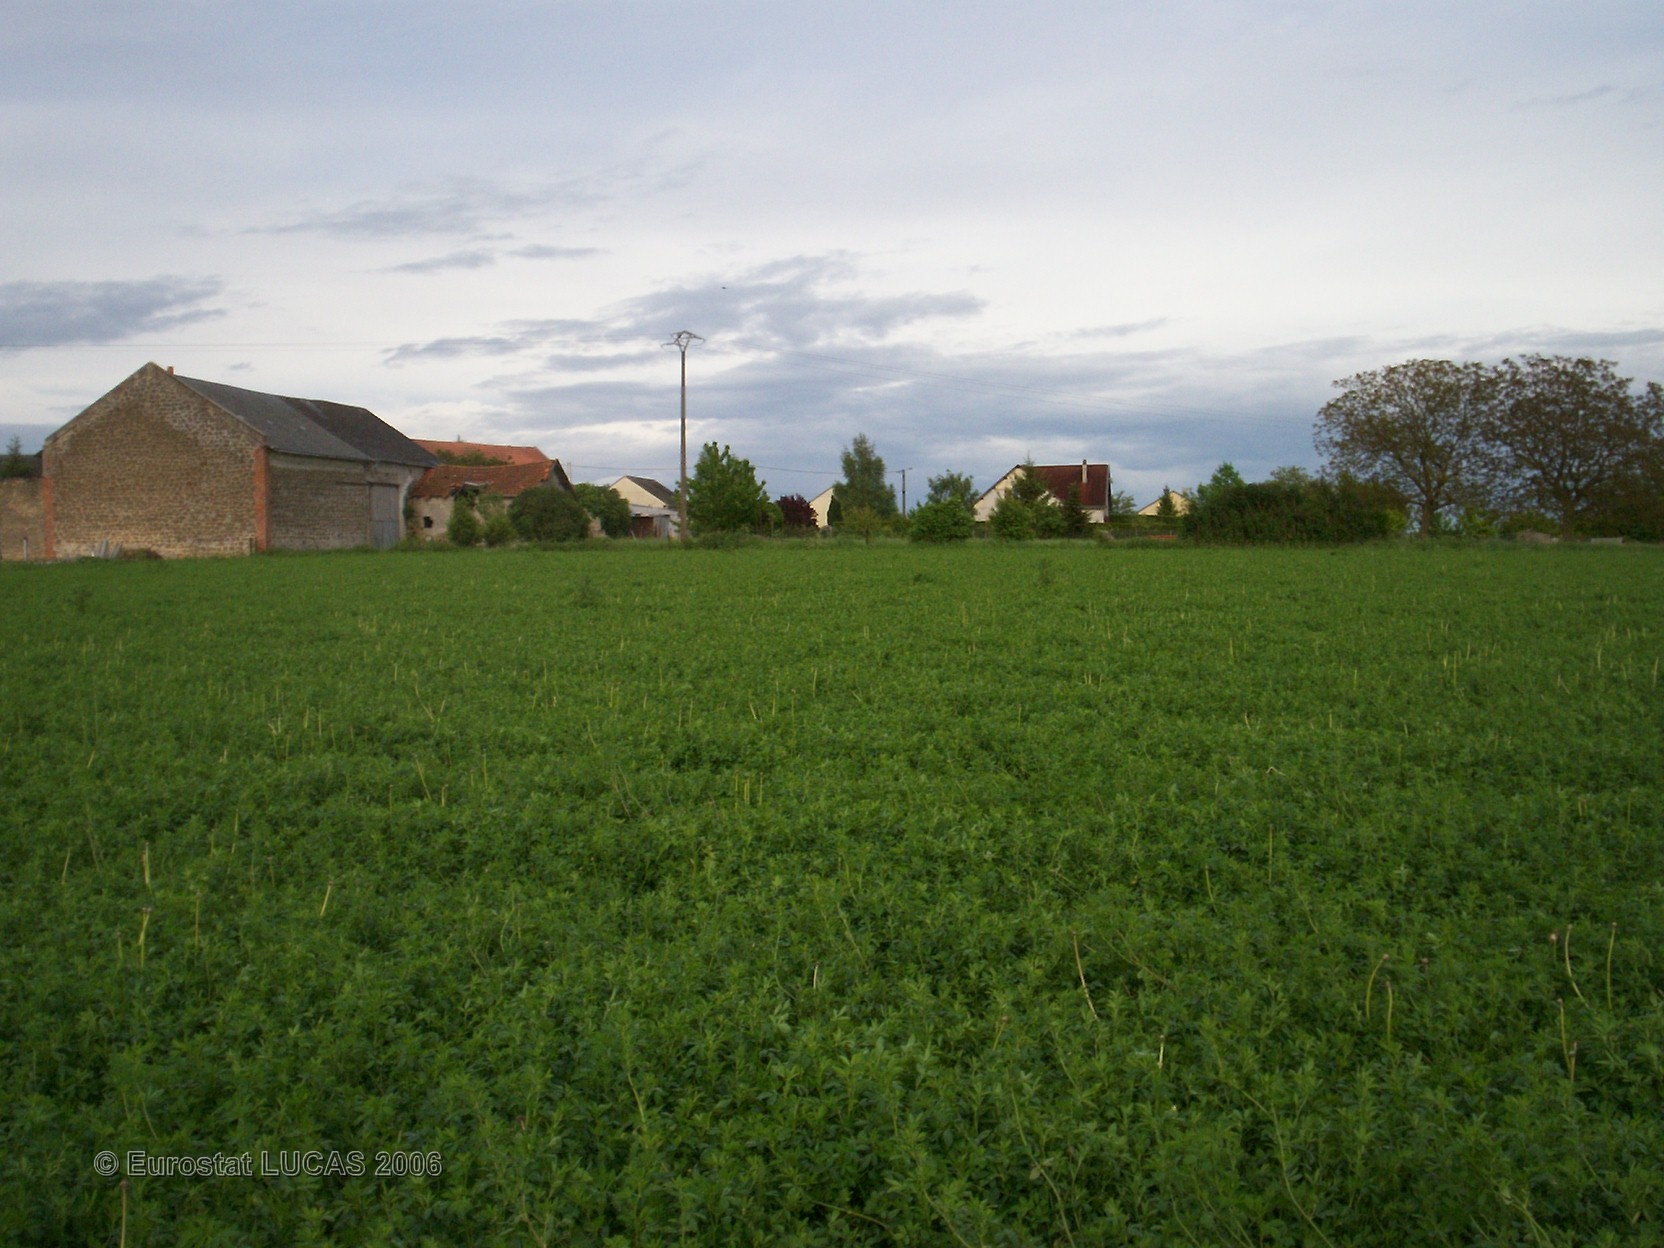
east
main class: Cropland
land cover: Lucerne
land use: Agriculture (excluding fallow land and kitchen gardens)
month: May
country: FR
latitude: 49.4495
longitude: 4.3542
